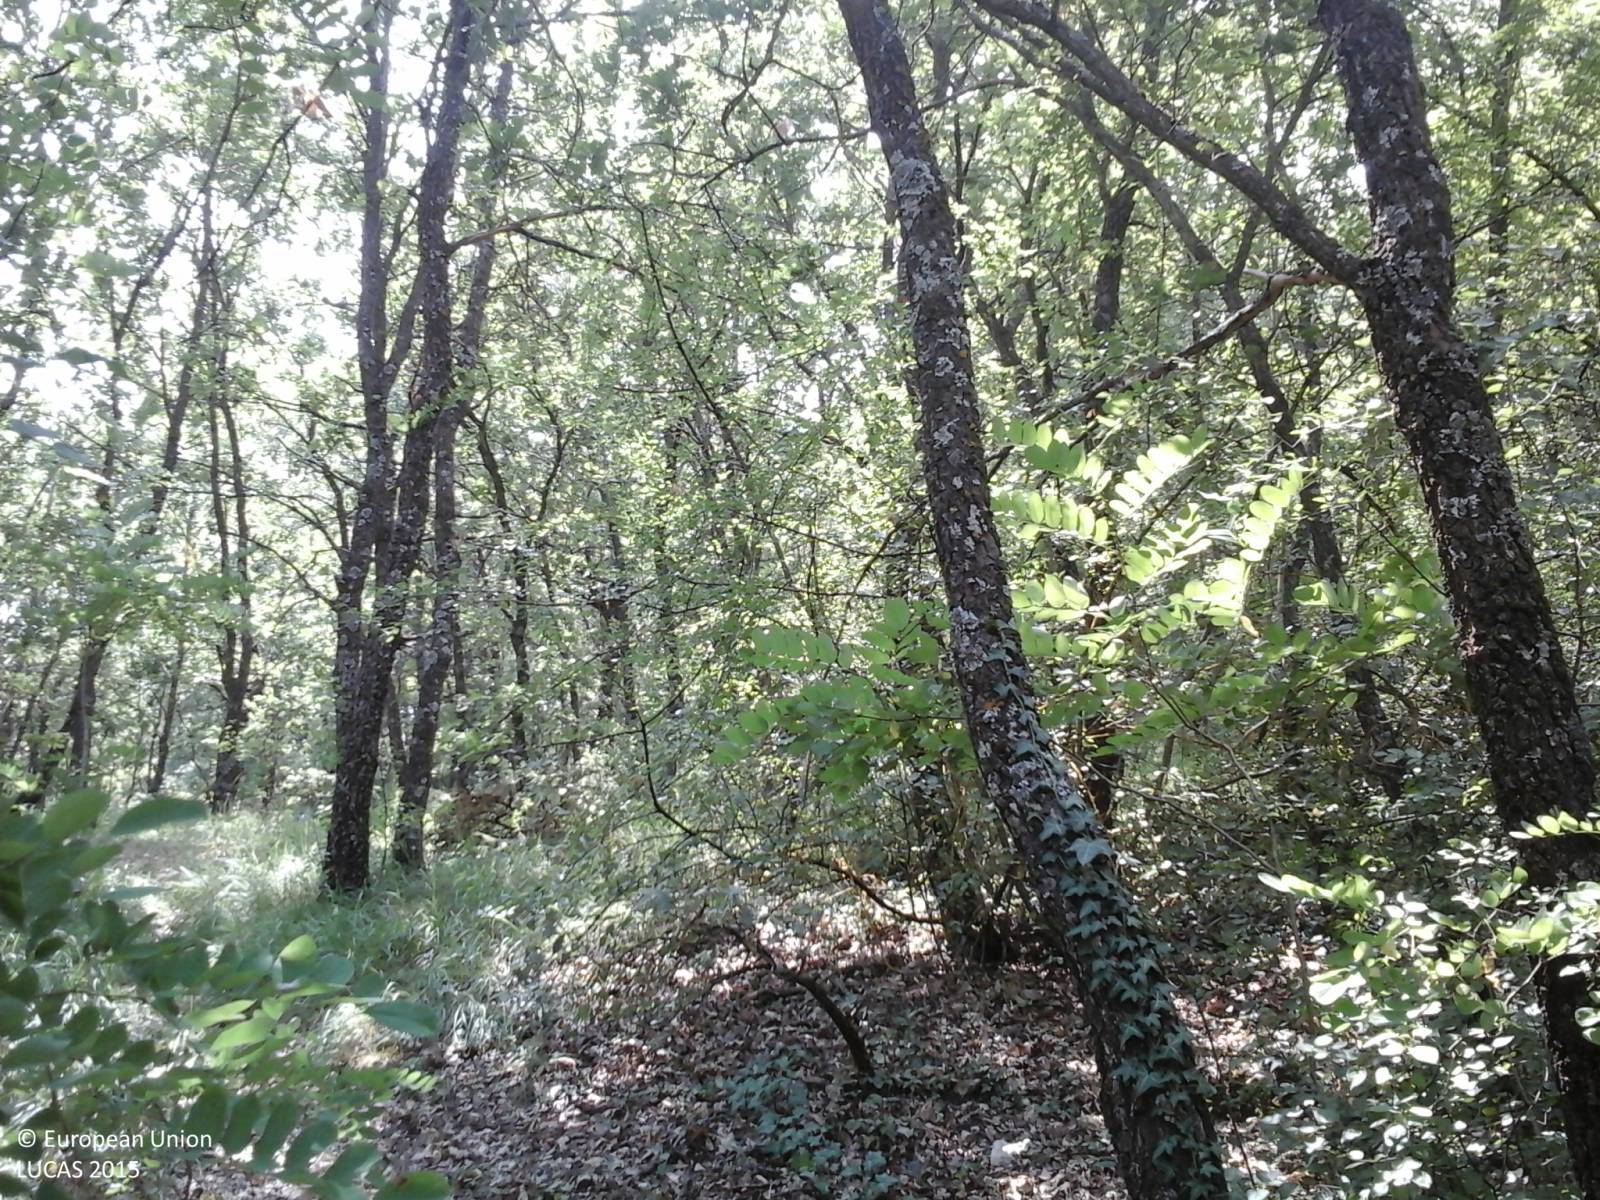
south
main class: Woodland
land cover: Broadleaved woodland
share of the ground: > 75 %
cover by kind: broadleaved forest trees 100 %
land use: Semi-natural and natural areas not in use
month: July
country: IT
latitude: 42.3258
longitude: 13.3989
